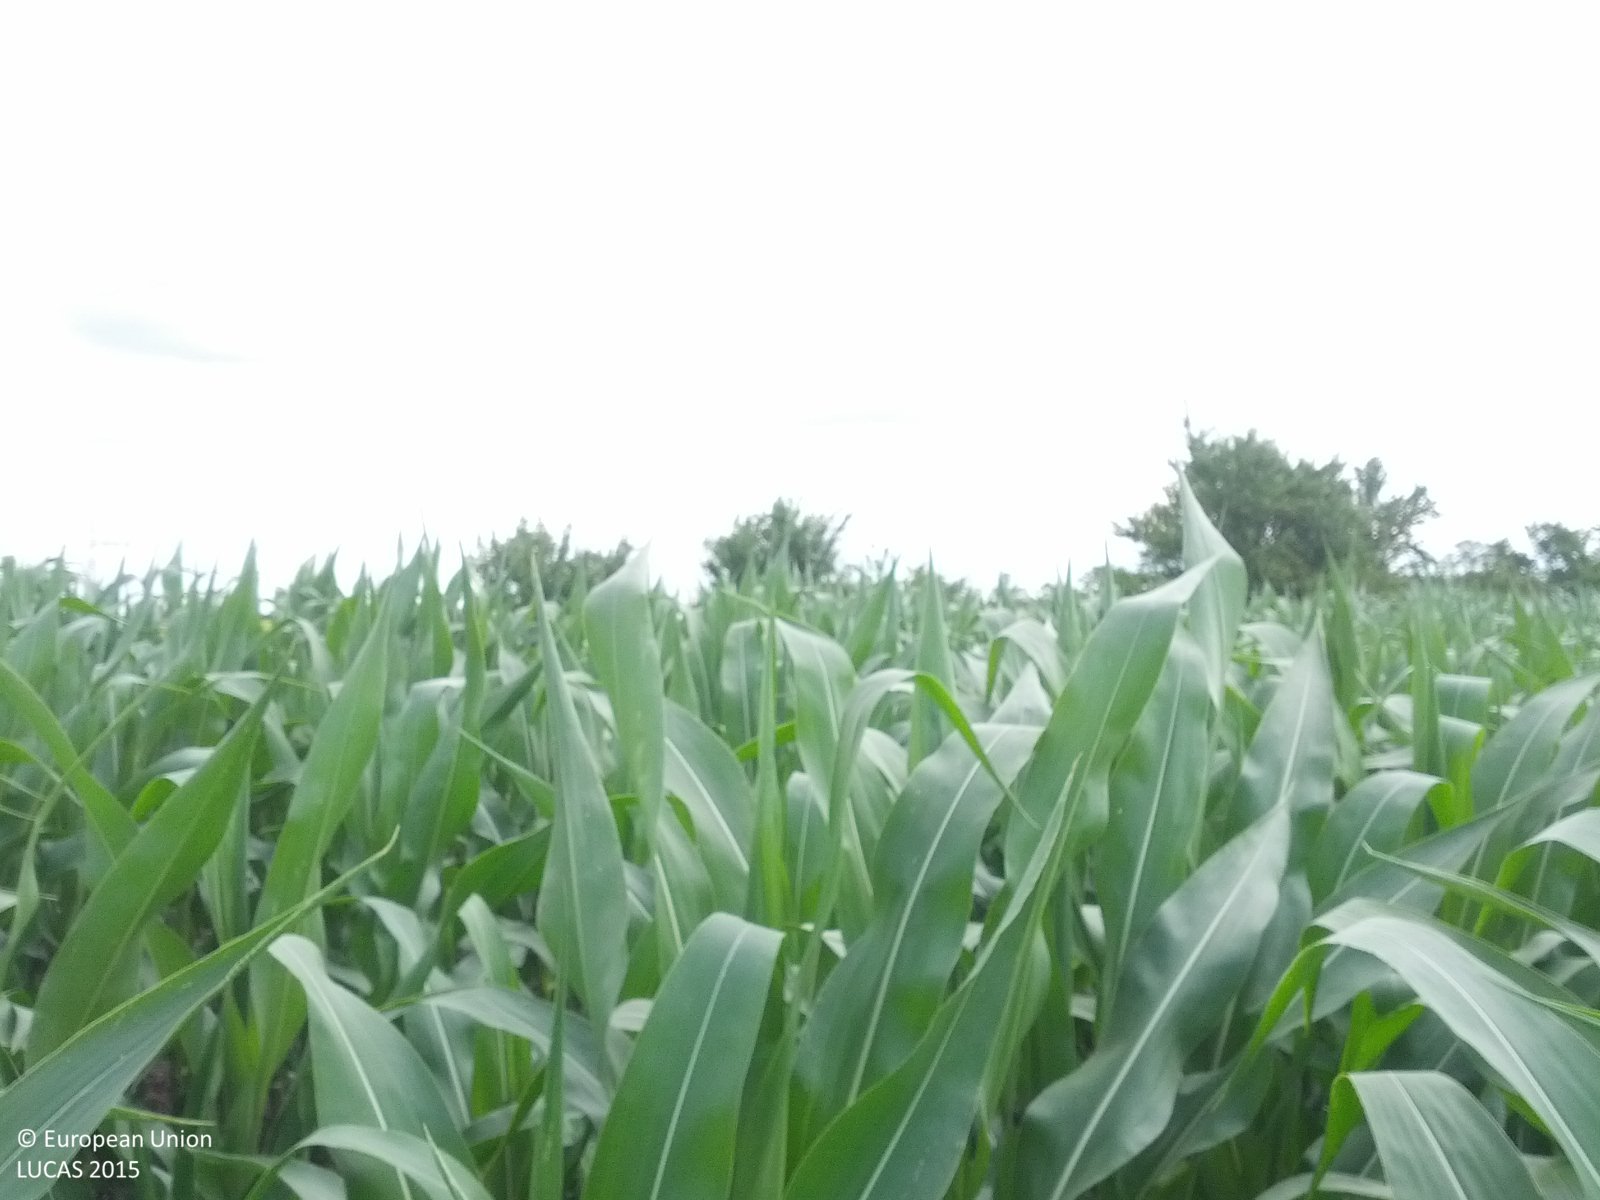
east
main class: Cropland
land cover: Maize
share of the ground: > 75 %
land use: Agriculture (excluding fallow land and kitchen gardens)
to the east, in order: Maize; Grass margins; Tracks; Grass margins; Shrubland with sparse tree cover; Rivers and streams; Grass margins; Tracks; Grass margins; Maize
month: July
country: AT
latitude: 48.7081
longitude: 16.3520
